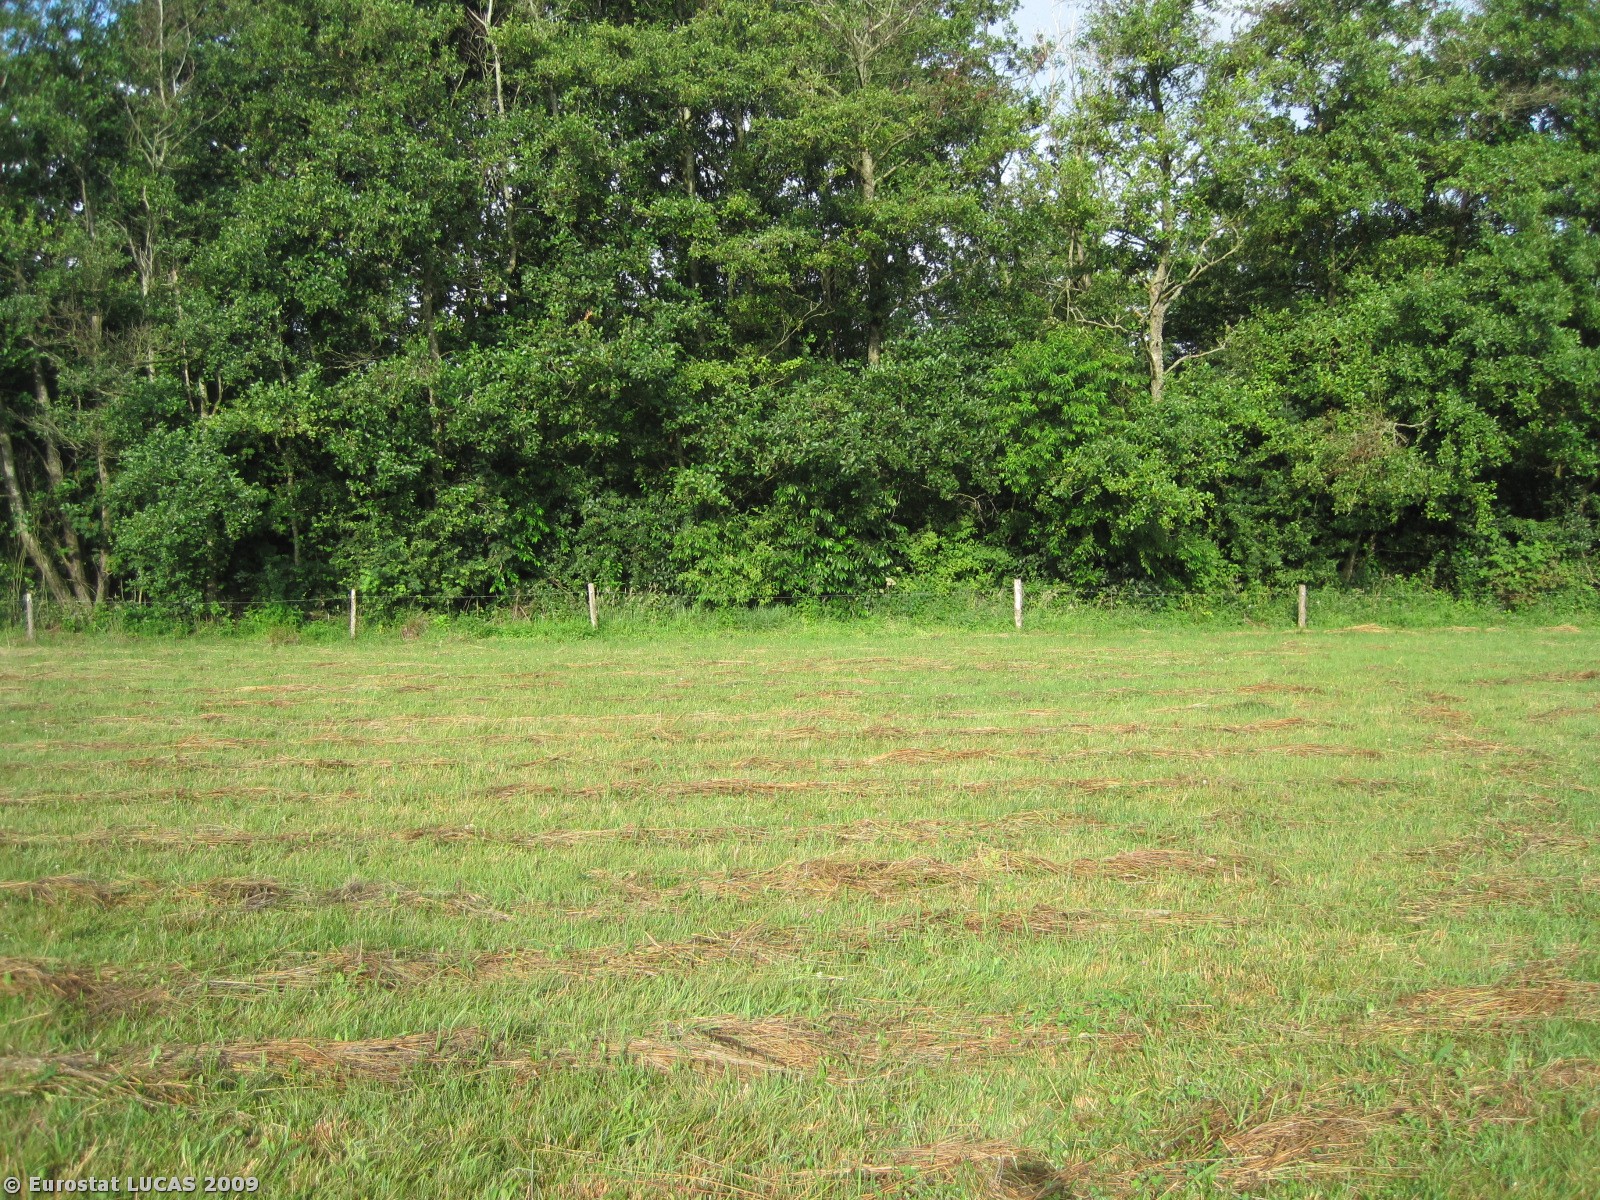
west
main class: Grassland
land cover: Grassland without tree/shrub cover
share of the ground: > 75 %
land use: Agriculture (excluding fallow land and kitchen gardens)
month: July
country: DK
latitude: 57.0463
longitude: 8.9302
